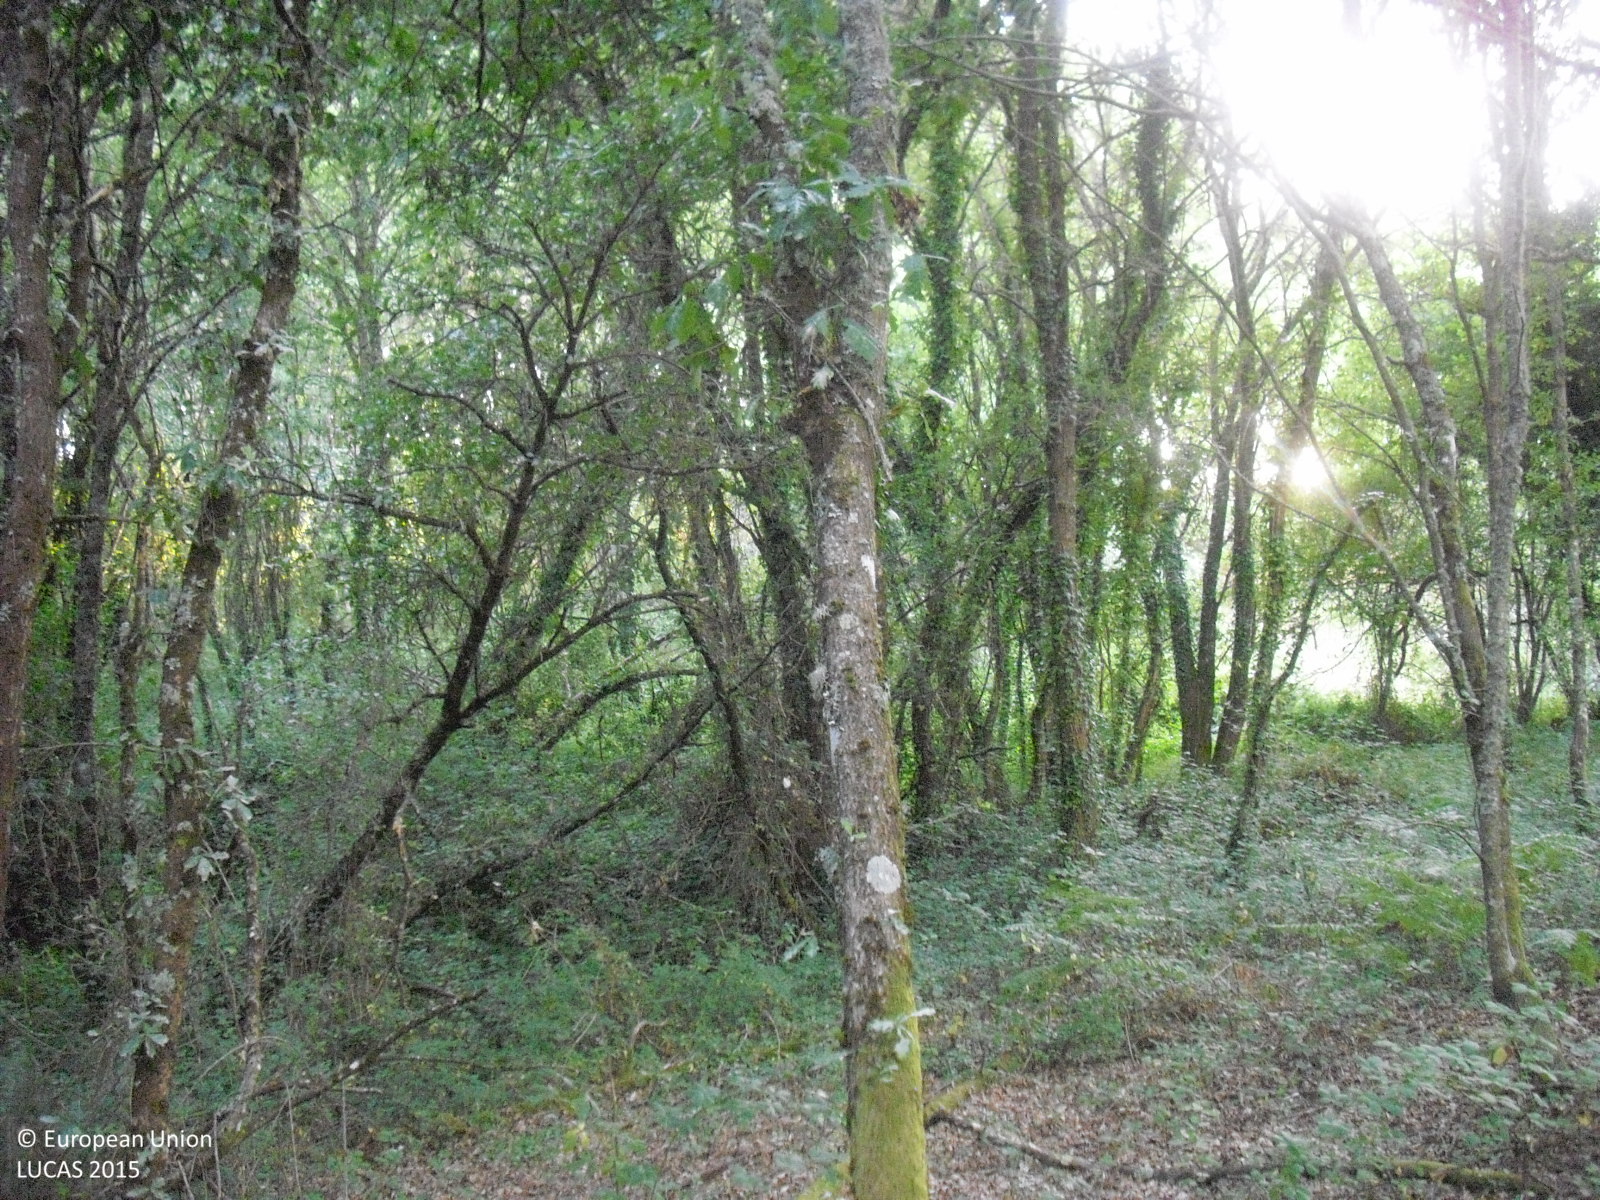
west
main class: Woodland
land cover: Broadleaved woodland
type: acidophilous oak and oak-birch forest
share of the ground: > 75 %
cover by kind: broadleaved forest trees 70 %, shrubs 30 %
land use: Forestry
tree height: > 5 m
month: July
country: ES
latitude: 42.3292
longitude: -7.7304
